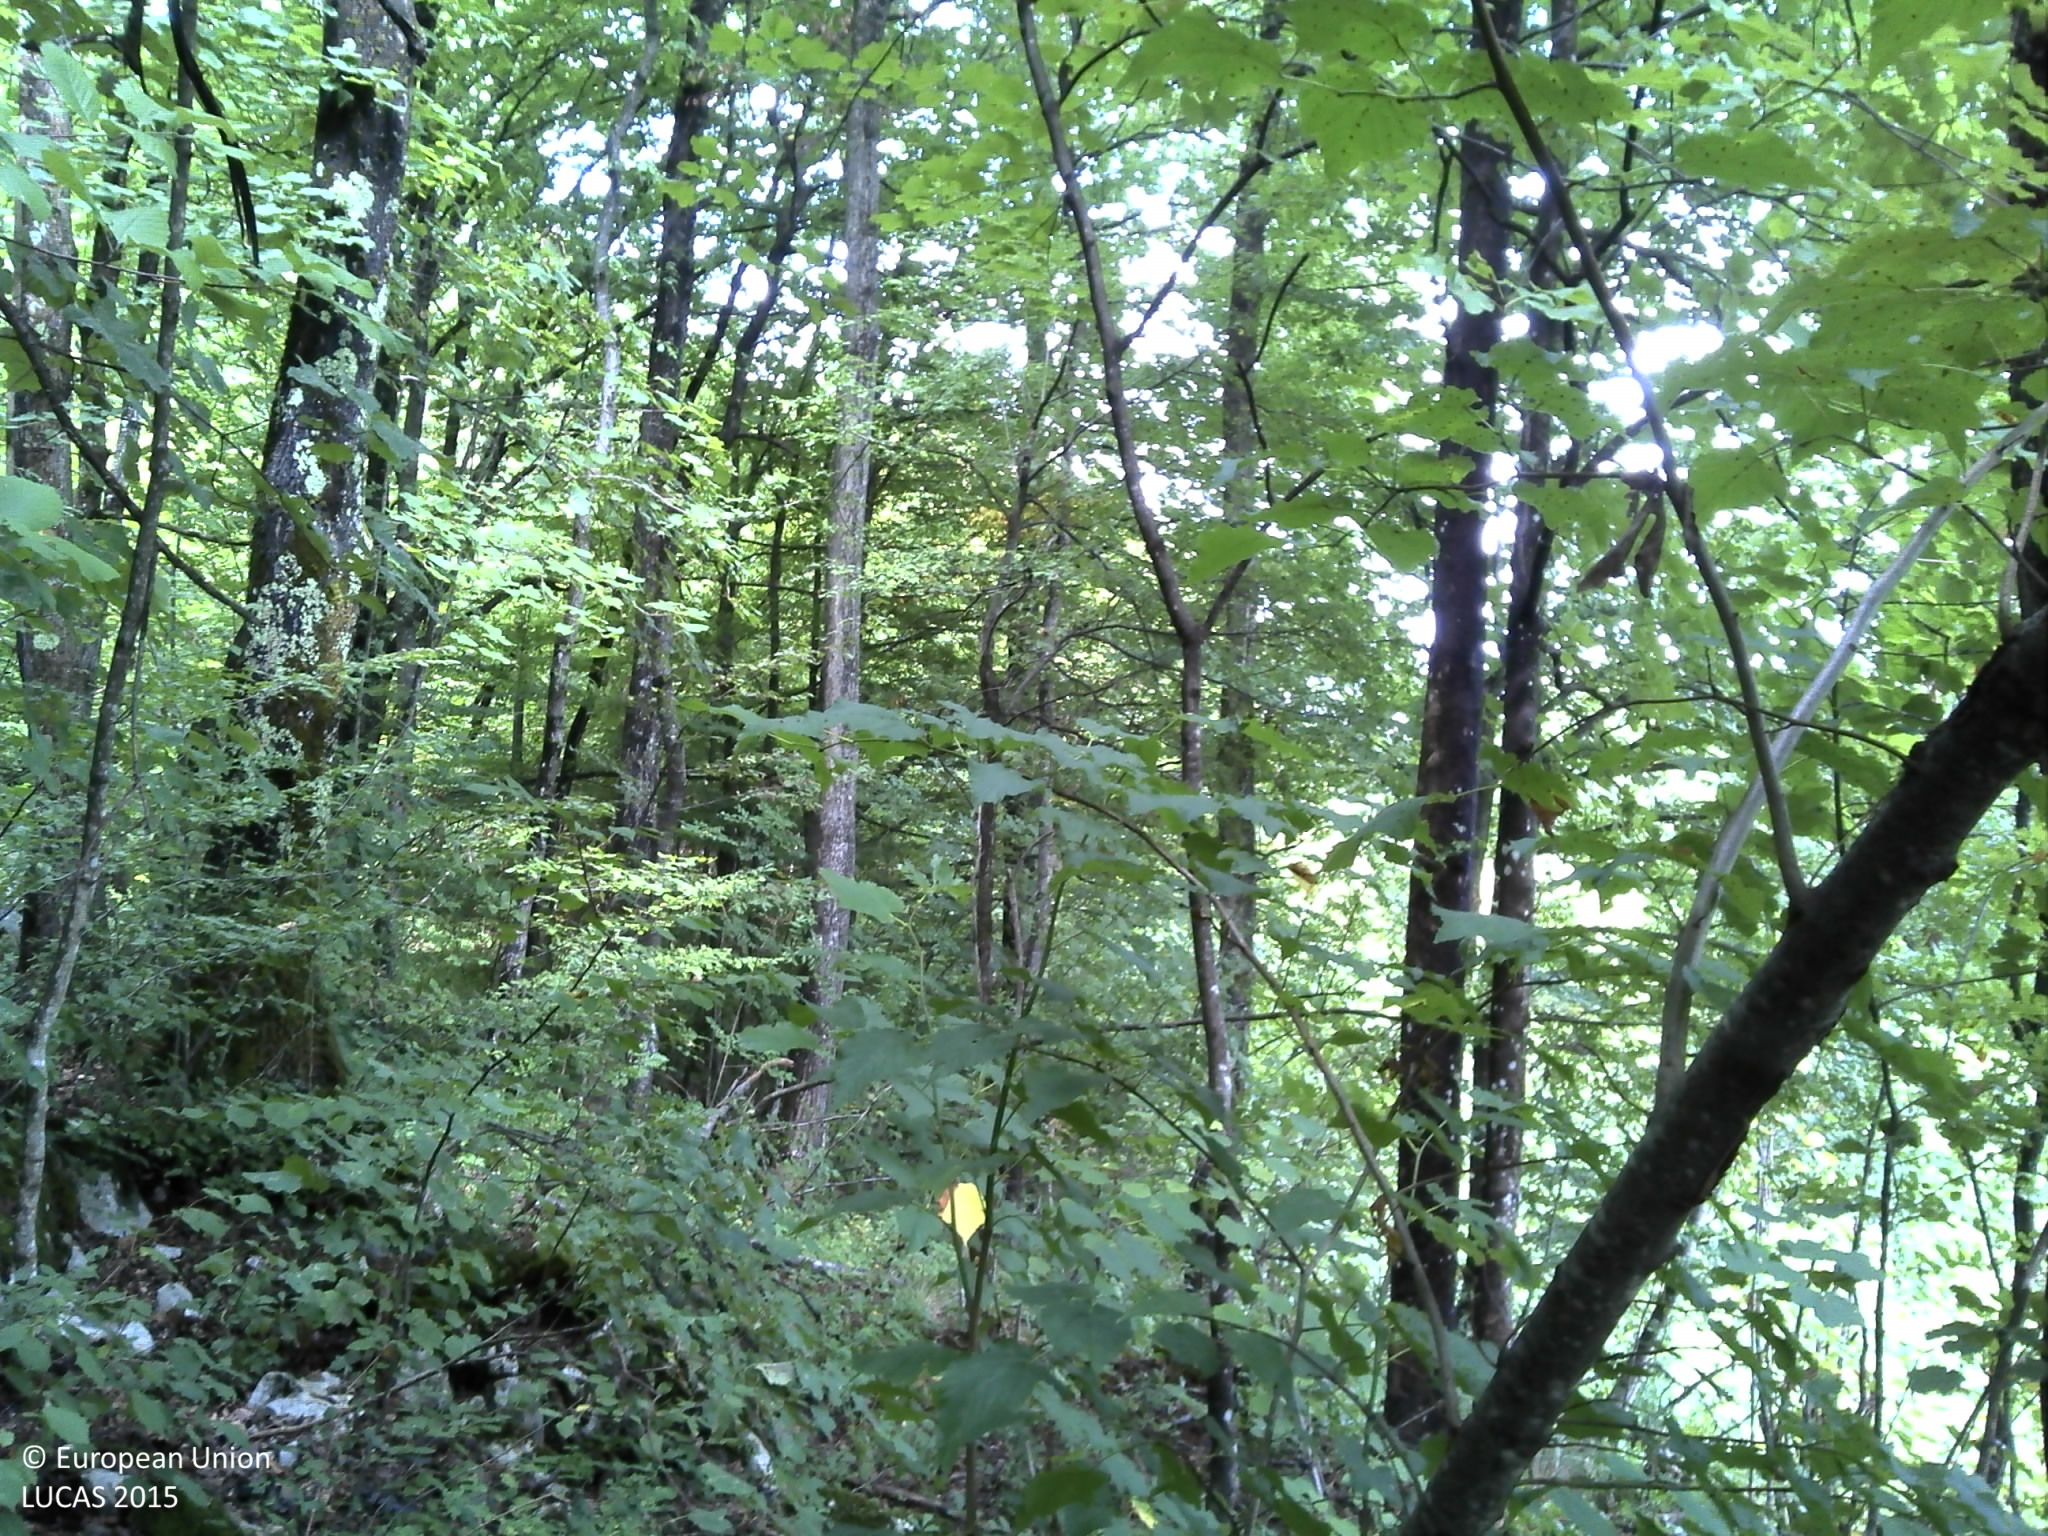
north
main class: Woodland
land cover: Broadleaved woodland
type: acidophilous oak and oak-birch forest
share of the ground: > 75 %
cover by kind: broadleaved forest trees 100 %
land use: Forestry
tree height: > 5 m
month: September
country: HR
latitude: 45.3010
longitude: 15.2623
